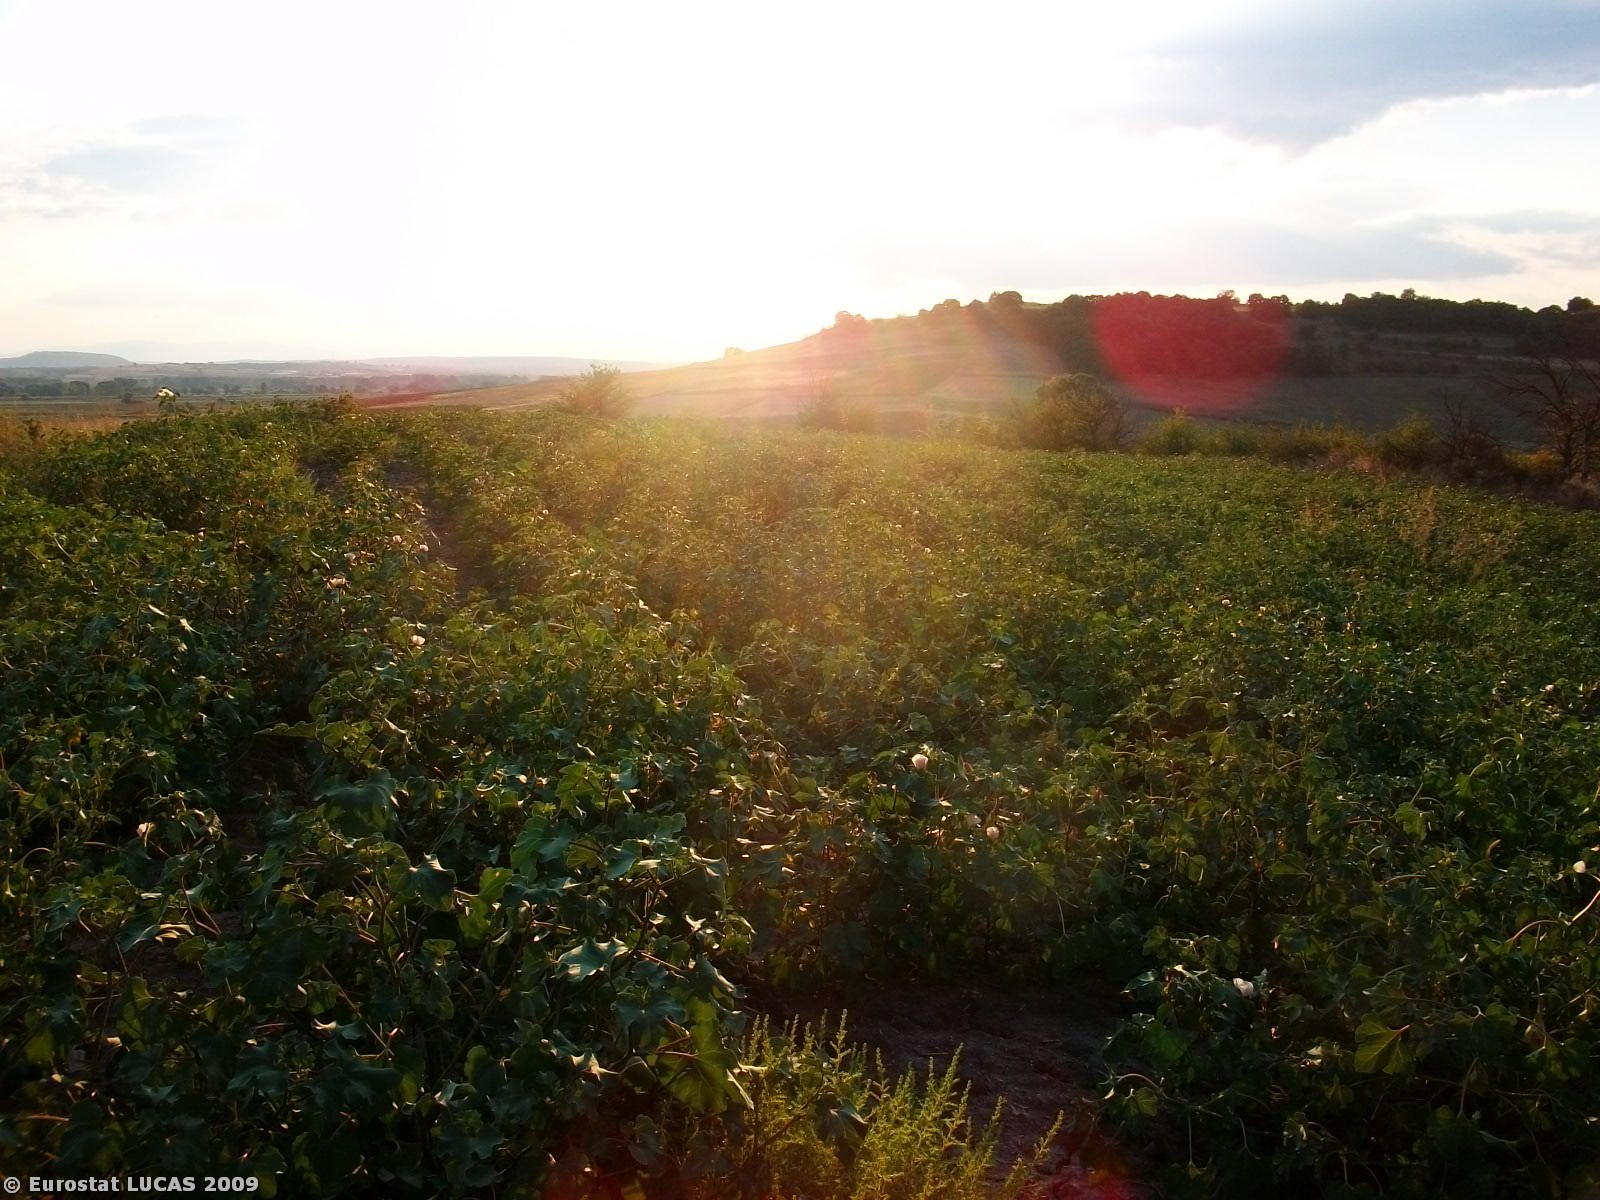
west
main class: Cropland
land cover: Cotton
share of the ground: 50 - 75 %
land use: Agriculture (excluding fallow land and kitchen gardens)
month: August
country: GR
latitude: 41.3944
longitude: 26.4250
